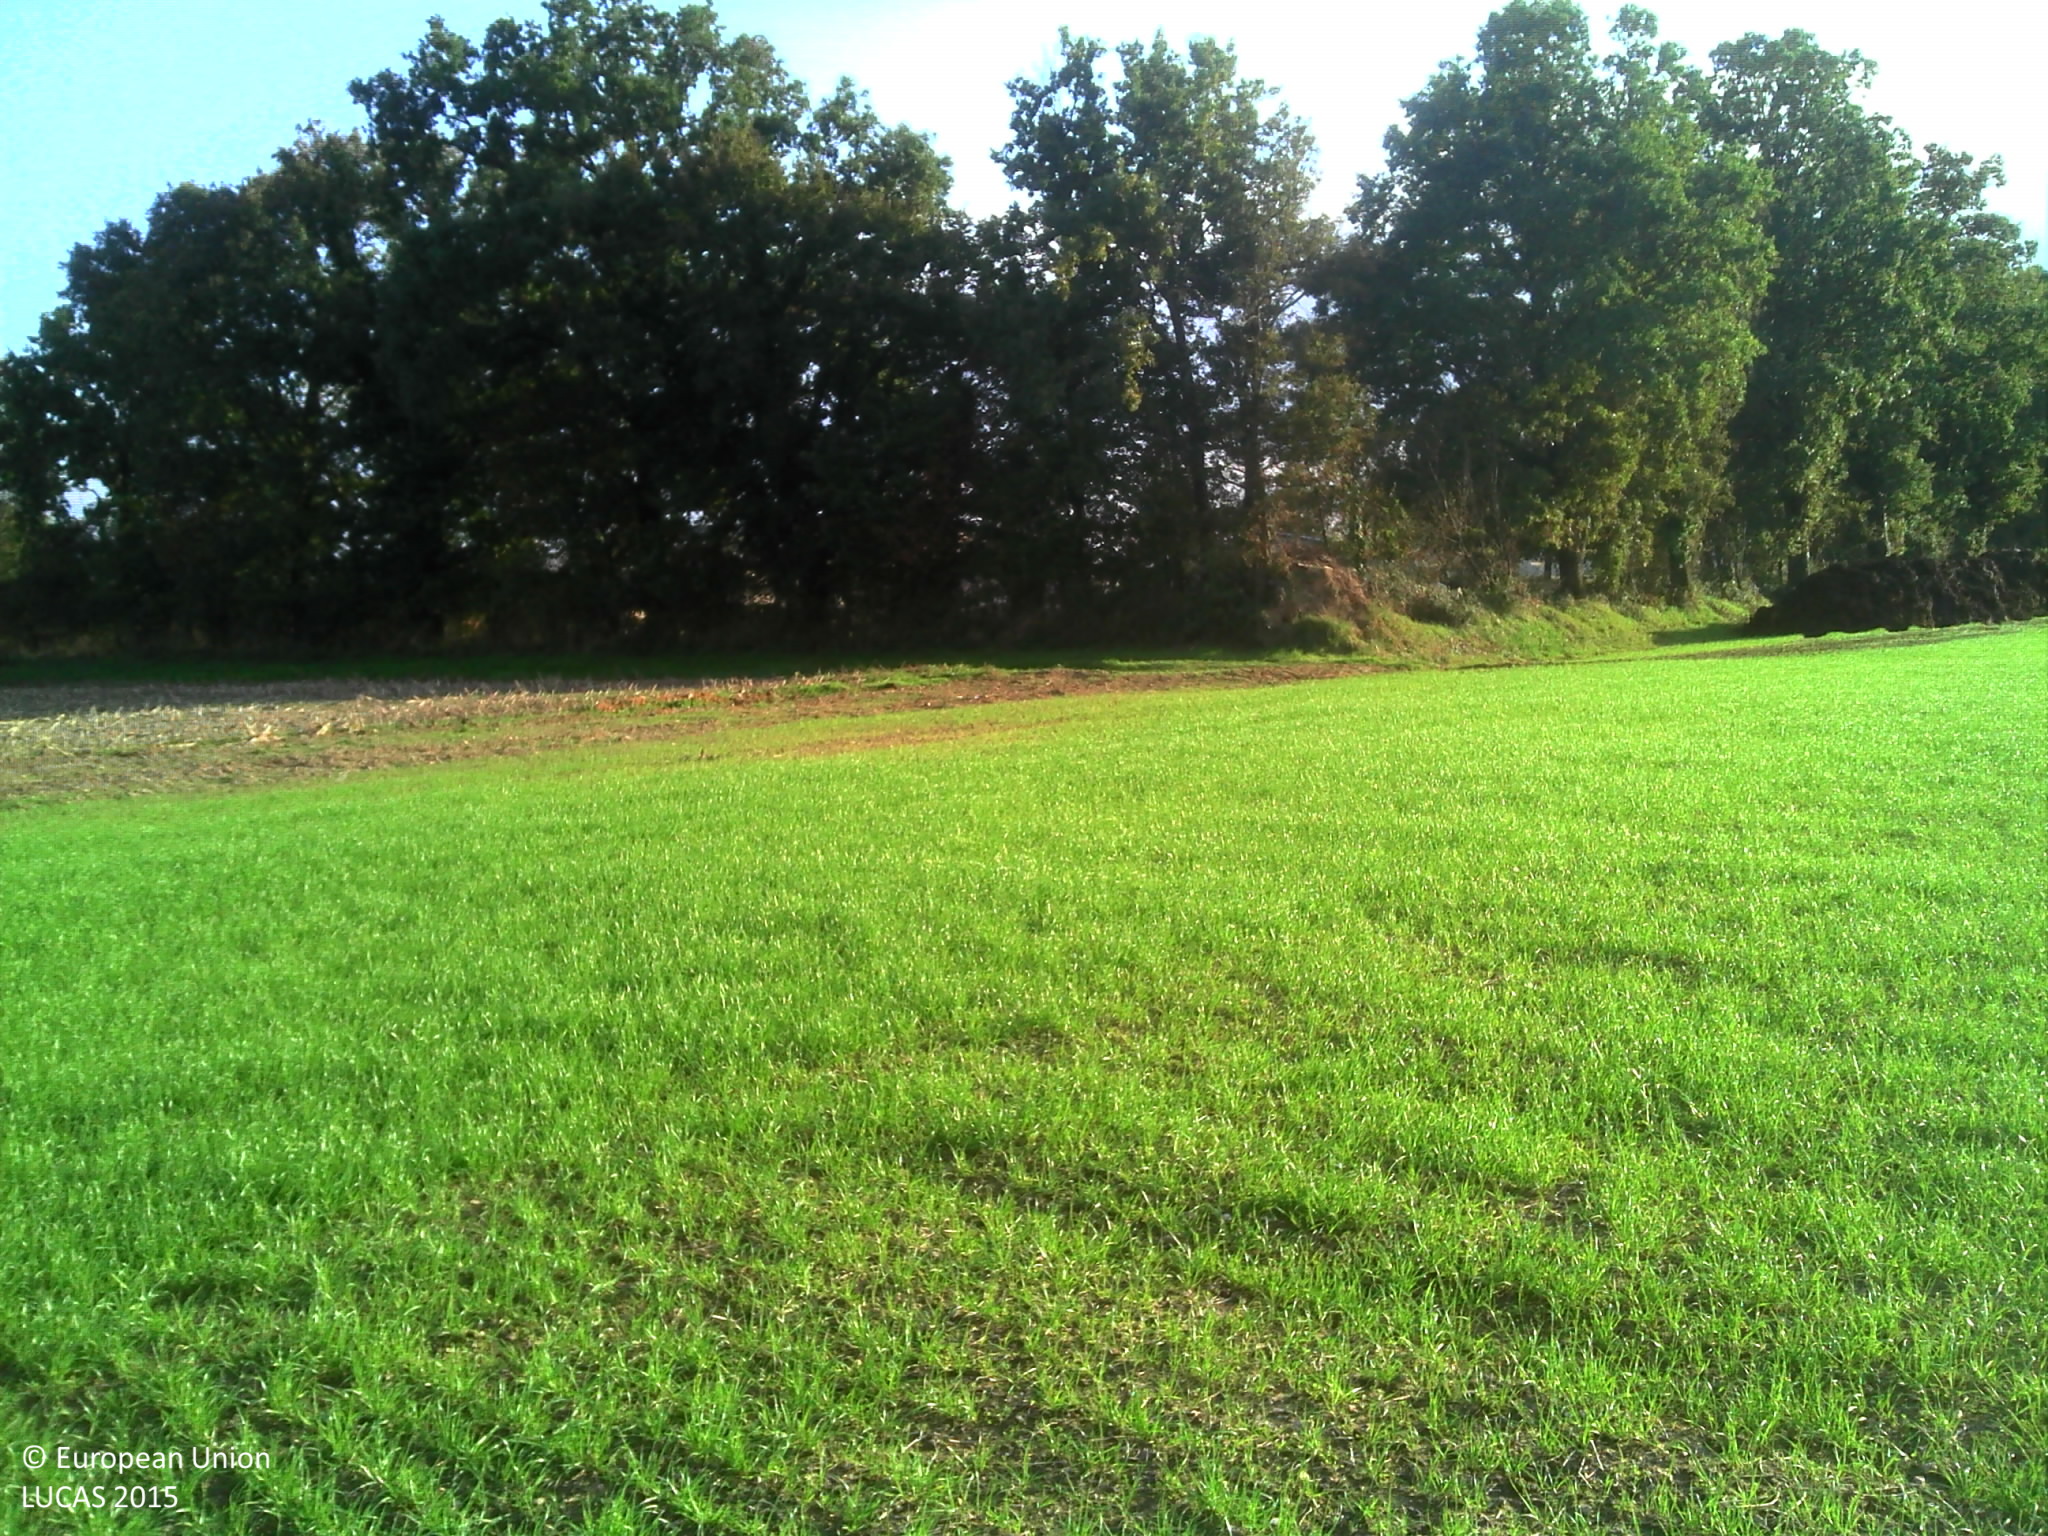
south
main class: Cropland
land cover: Temporary grasslands
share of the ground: 50 - 75 %
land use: Agriculture (excluding fallow land and kitchen gardens)
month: October
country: FR
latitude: 46.6067
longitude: -1.6204
